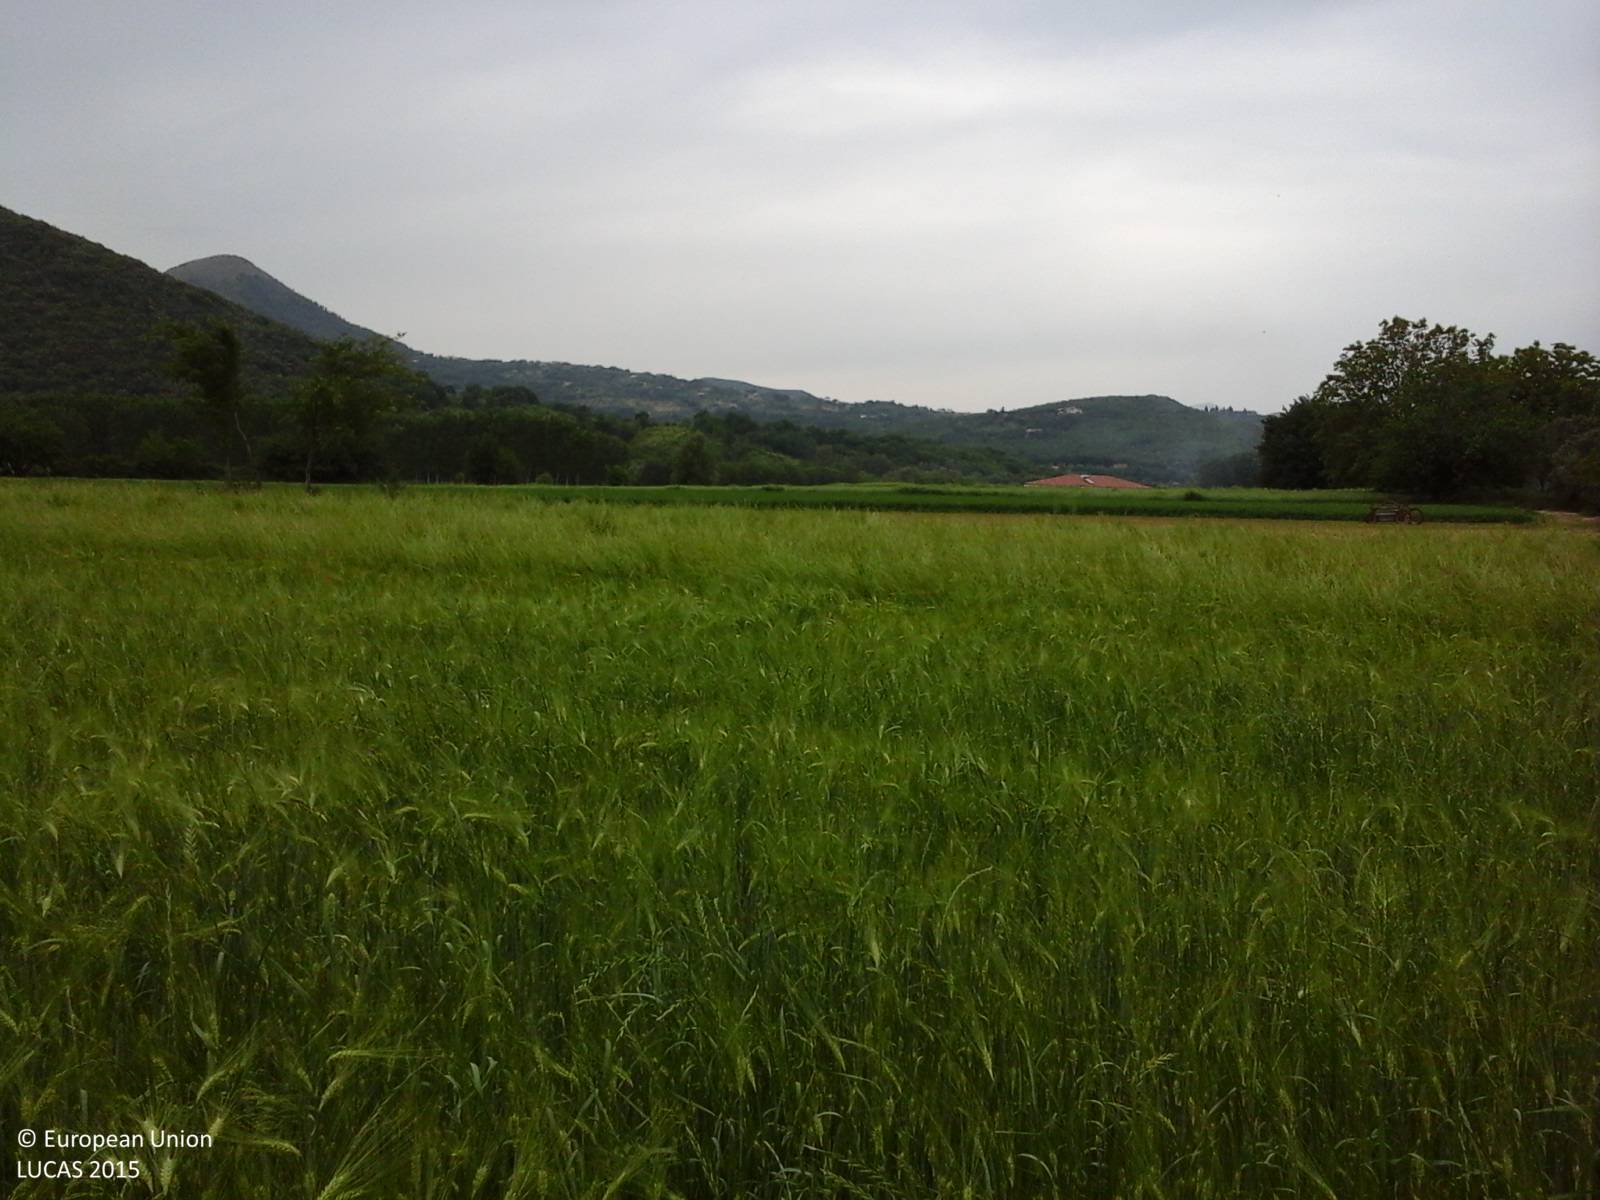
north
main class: Cropland
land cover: Barley
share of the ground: > 75 %
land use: Agriculture (excluding fallow land and kitchen gardens)
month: May
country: IT
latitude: 41.1489
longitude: 14.3559
